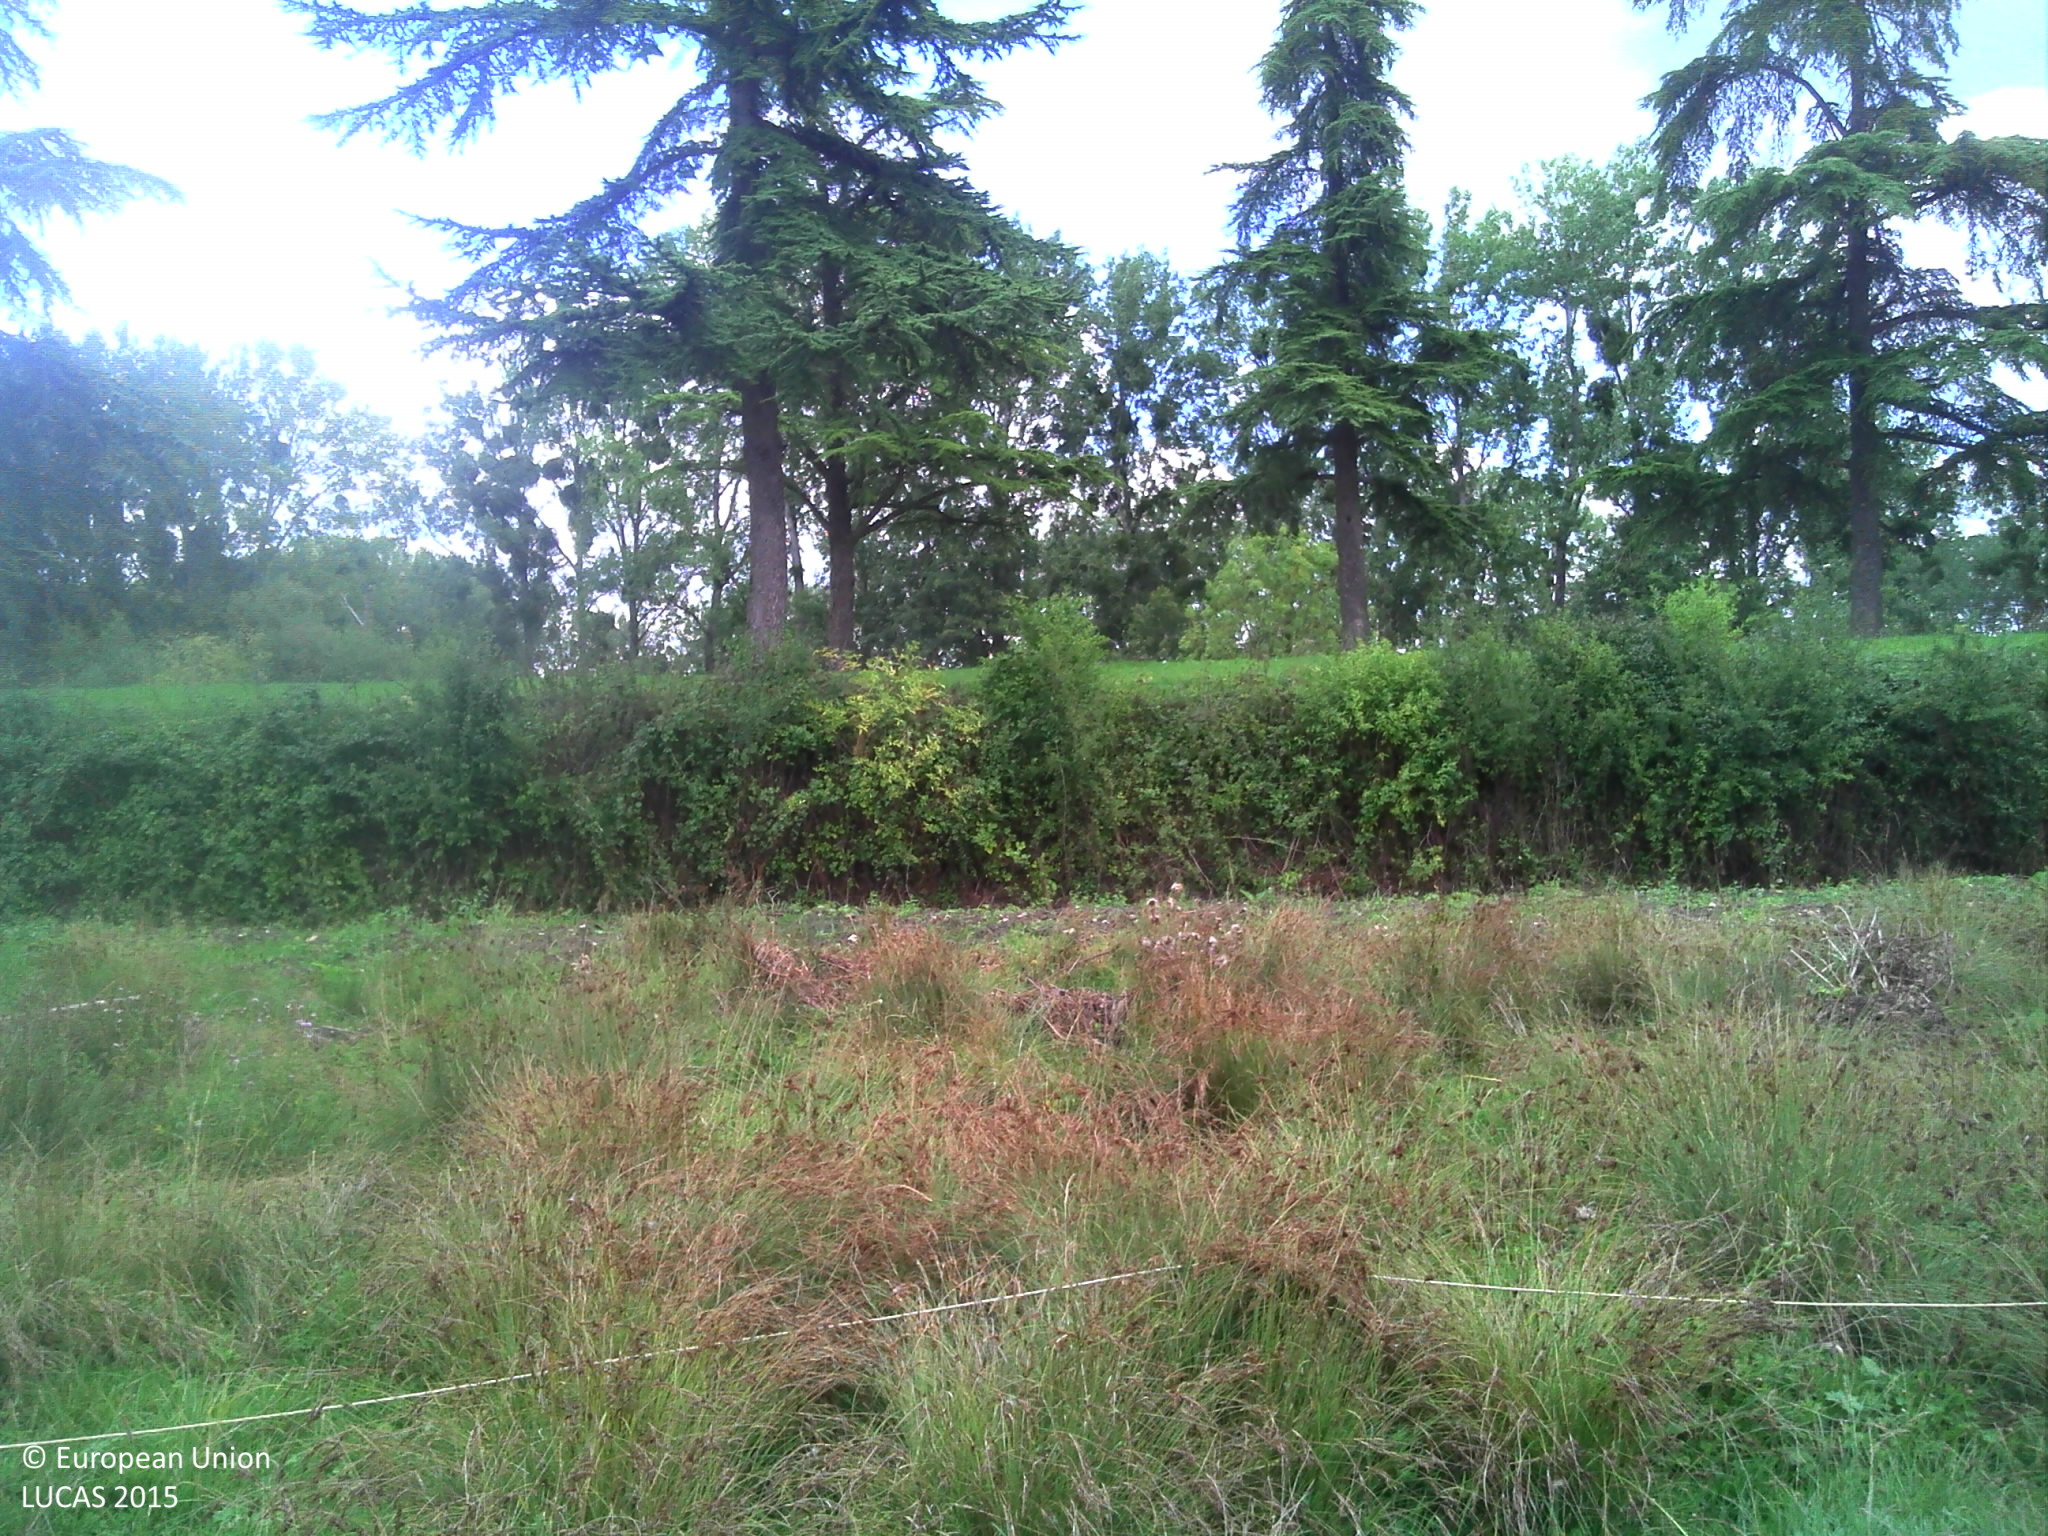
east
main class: Grassland
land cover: Grassland without tree/shrub cover
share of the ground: > 75 %
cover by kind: herbaceous plants 95 %, shrubs 5 %
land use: Agriculture (excluding fallow land and kitchen gardens)
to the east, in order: Grassland without tree/shrub cover; Fences; Grassland without tree/shrub cover; Ditches and canals; Abandoned hedges; Grass margins; Paved roads, cycling and walking lanes; Grass margins; Lines of trees; Fences; Grassland without tree/shrub cover; Ponds and wetlands; Grassland without tree/shrub cover; Fences; Rivers and streams; Broadleaved woodland; Fences; Grassland without tree/shrub cover; Fences; Broadleaved woodland
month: September
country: FR
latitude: 48.3038
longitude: 0.5252
